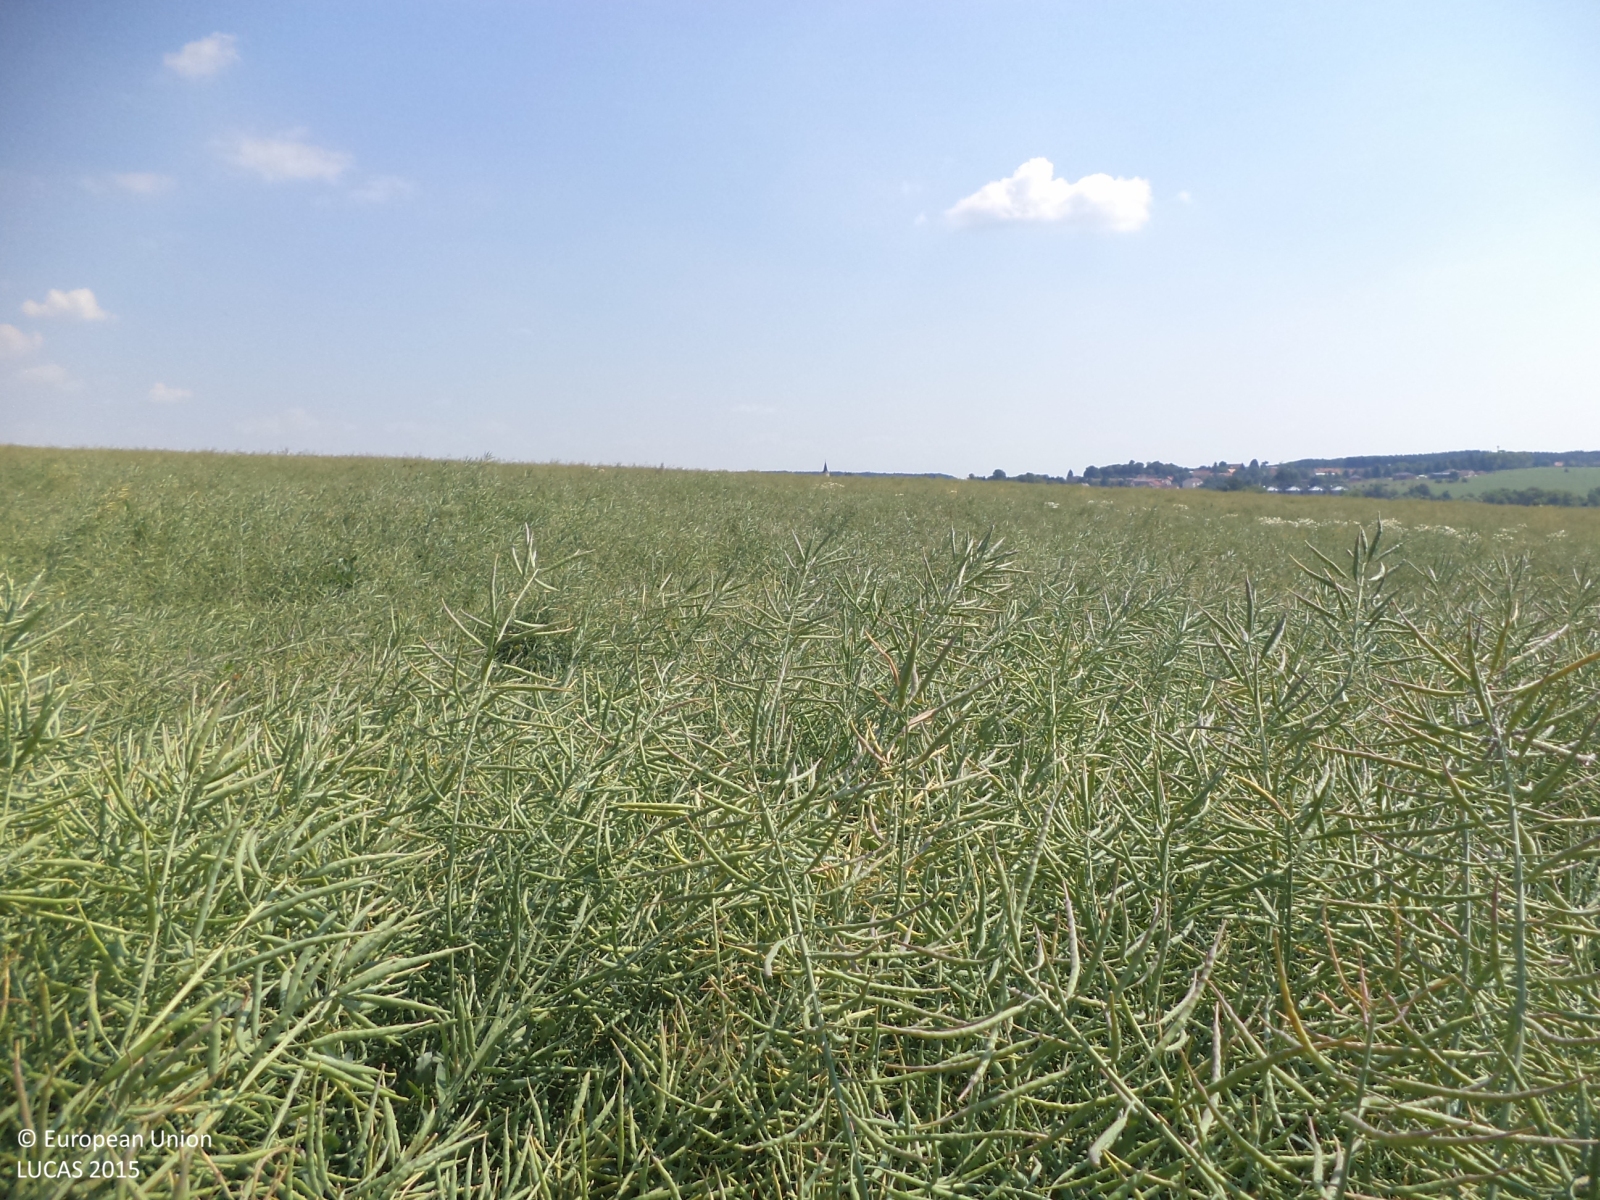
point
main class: Cropland
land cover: Rape and turnip rape
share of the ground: > 75 %
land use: Agriculture (excluding fallow land and kitchen gardens)
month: July
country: CZ
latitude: 49.3622
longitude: 14.3660
